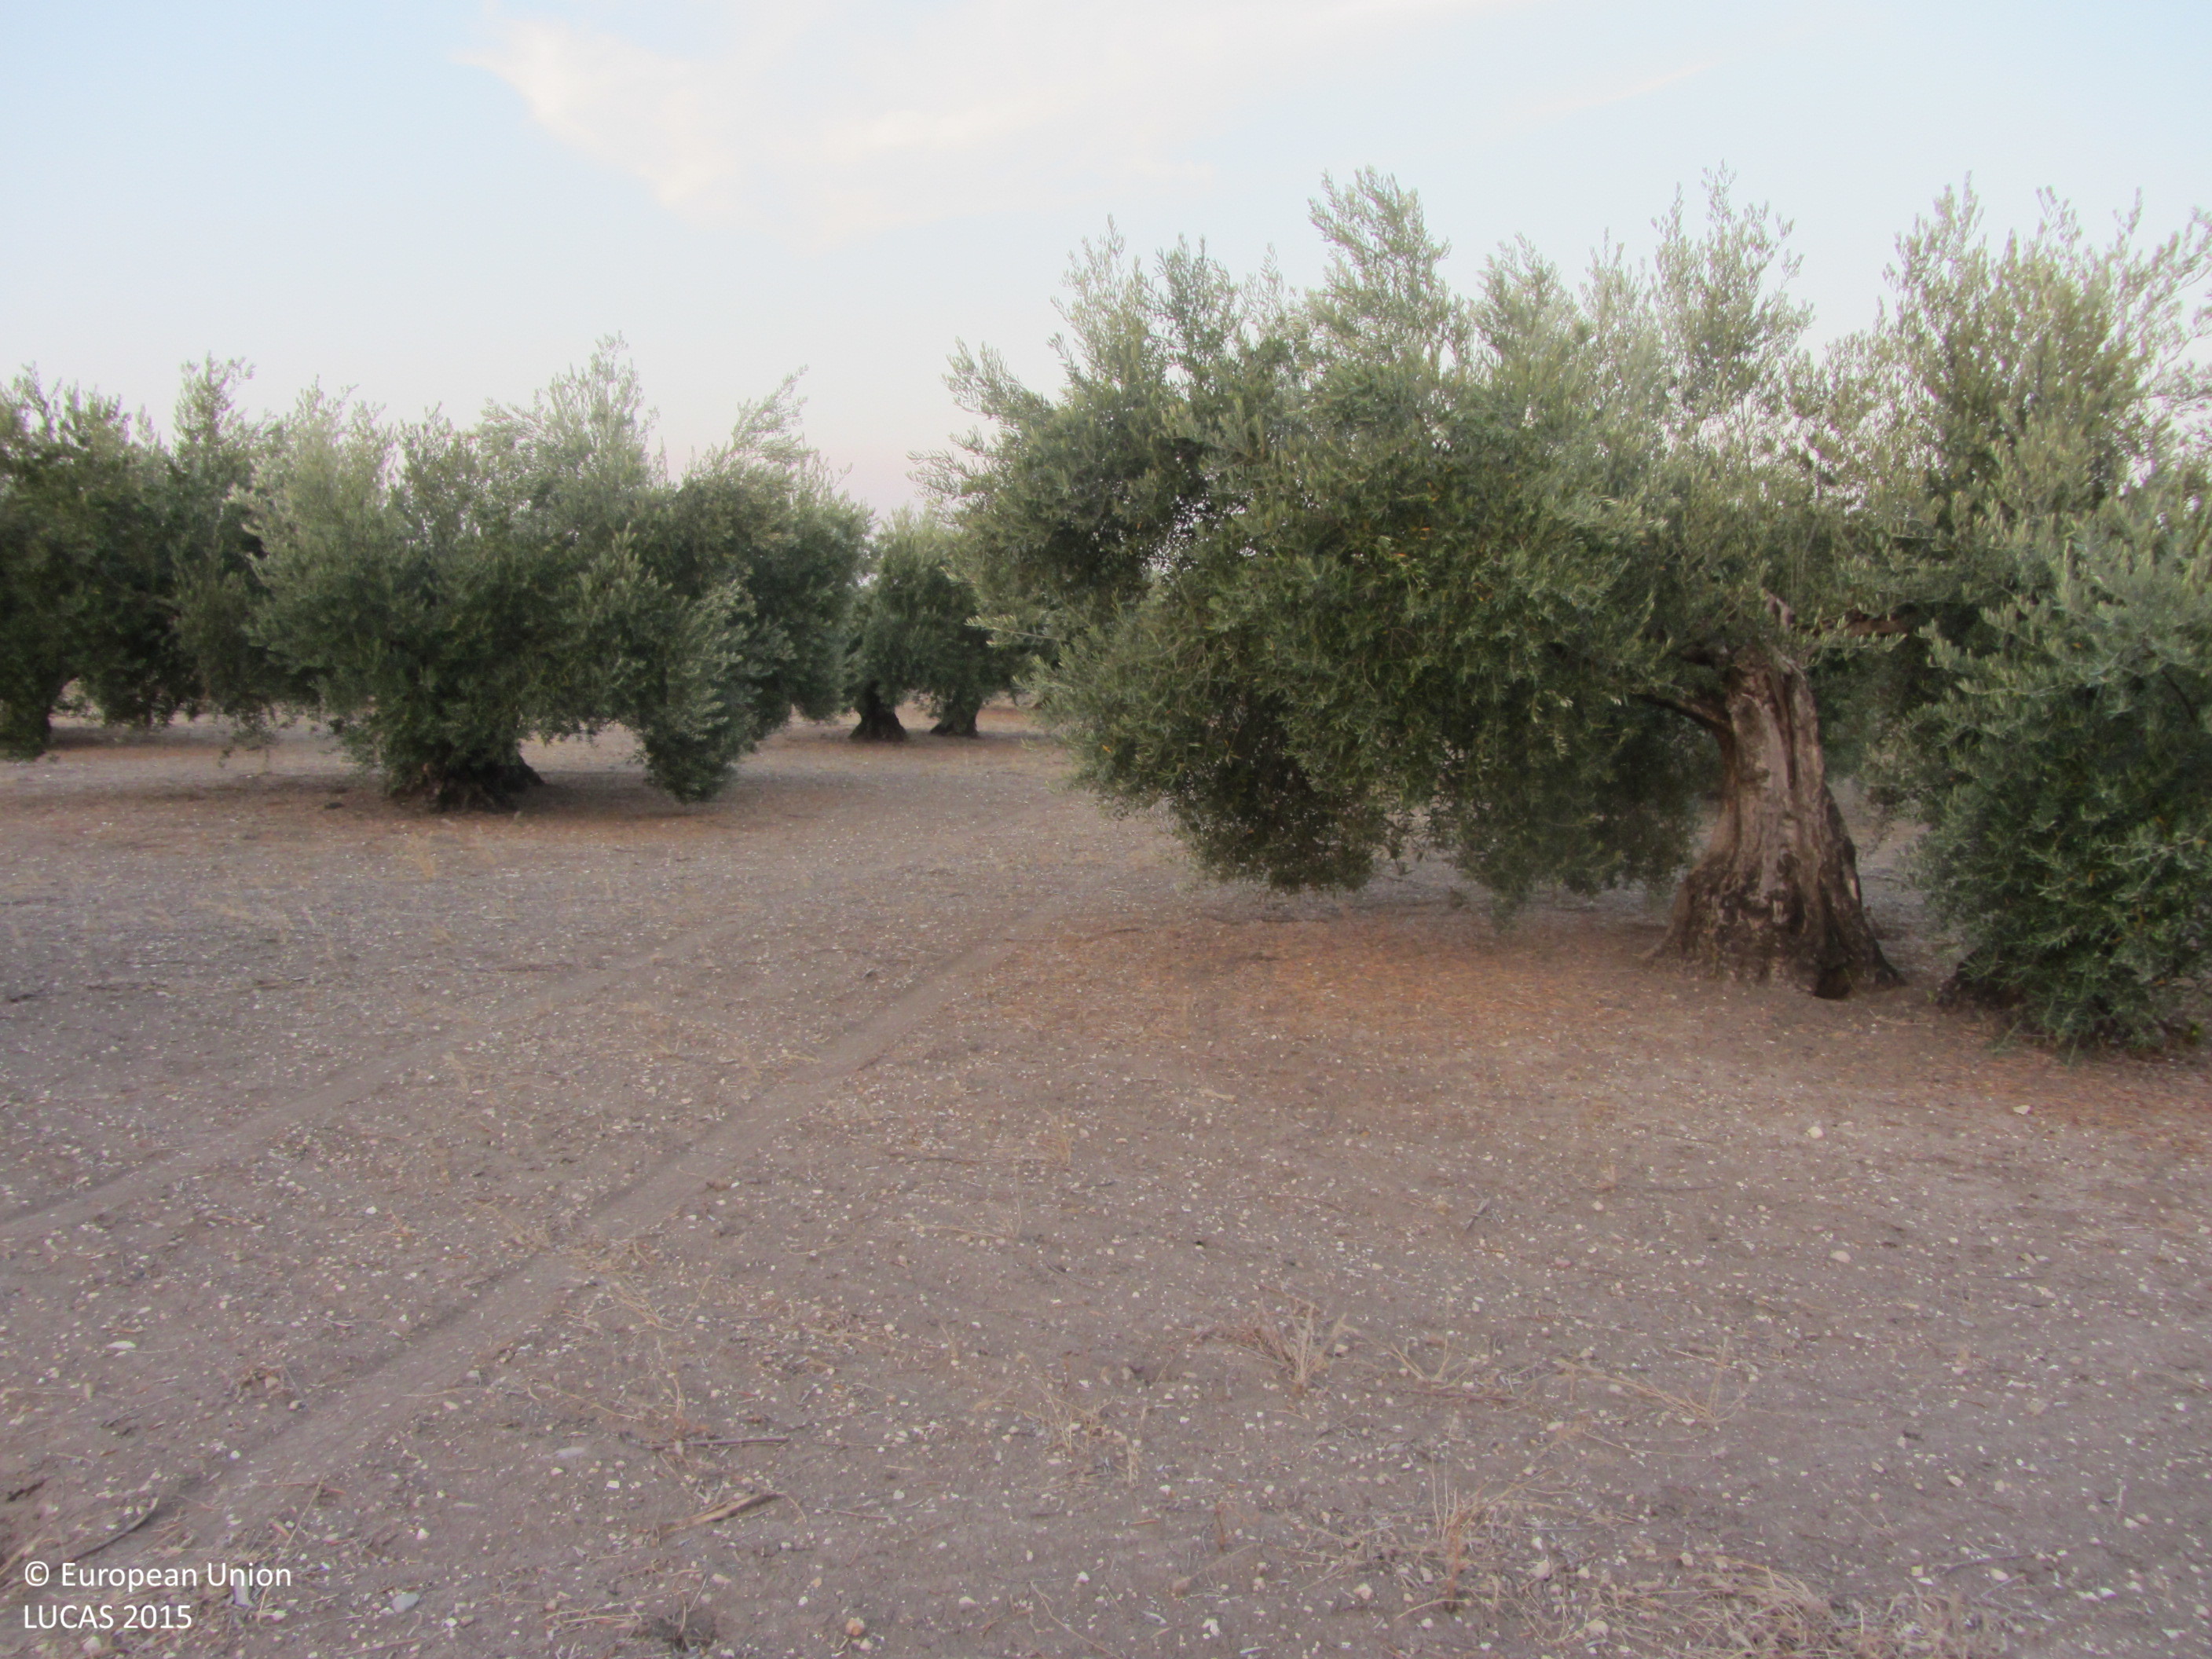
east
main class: Cropland
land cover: Olive groves
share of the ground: 25 - 50 %
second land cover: Other bare soil
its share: > 75 %
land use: Agriculture (excluding fallow land and kitchen gardens)
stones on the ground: < 10 %
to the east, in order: Olive groves; Other bare soil; Tracks; Olive groves
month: July
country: ES
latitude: 37.8374
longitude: -4.1755
